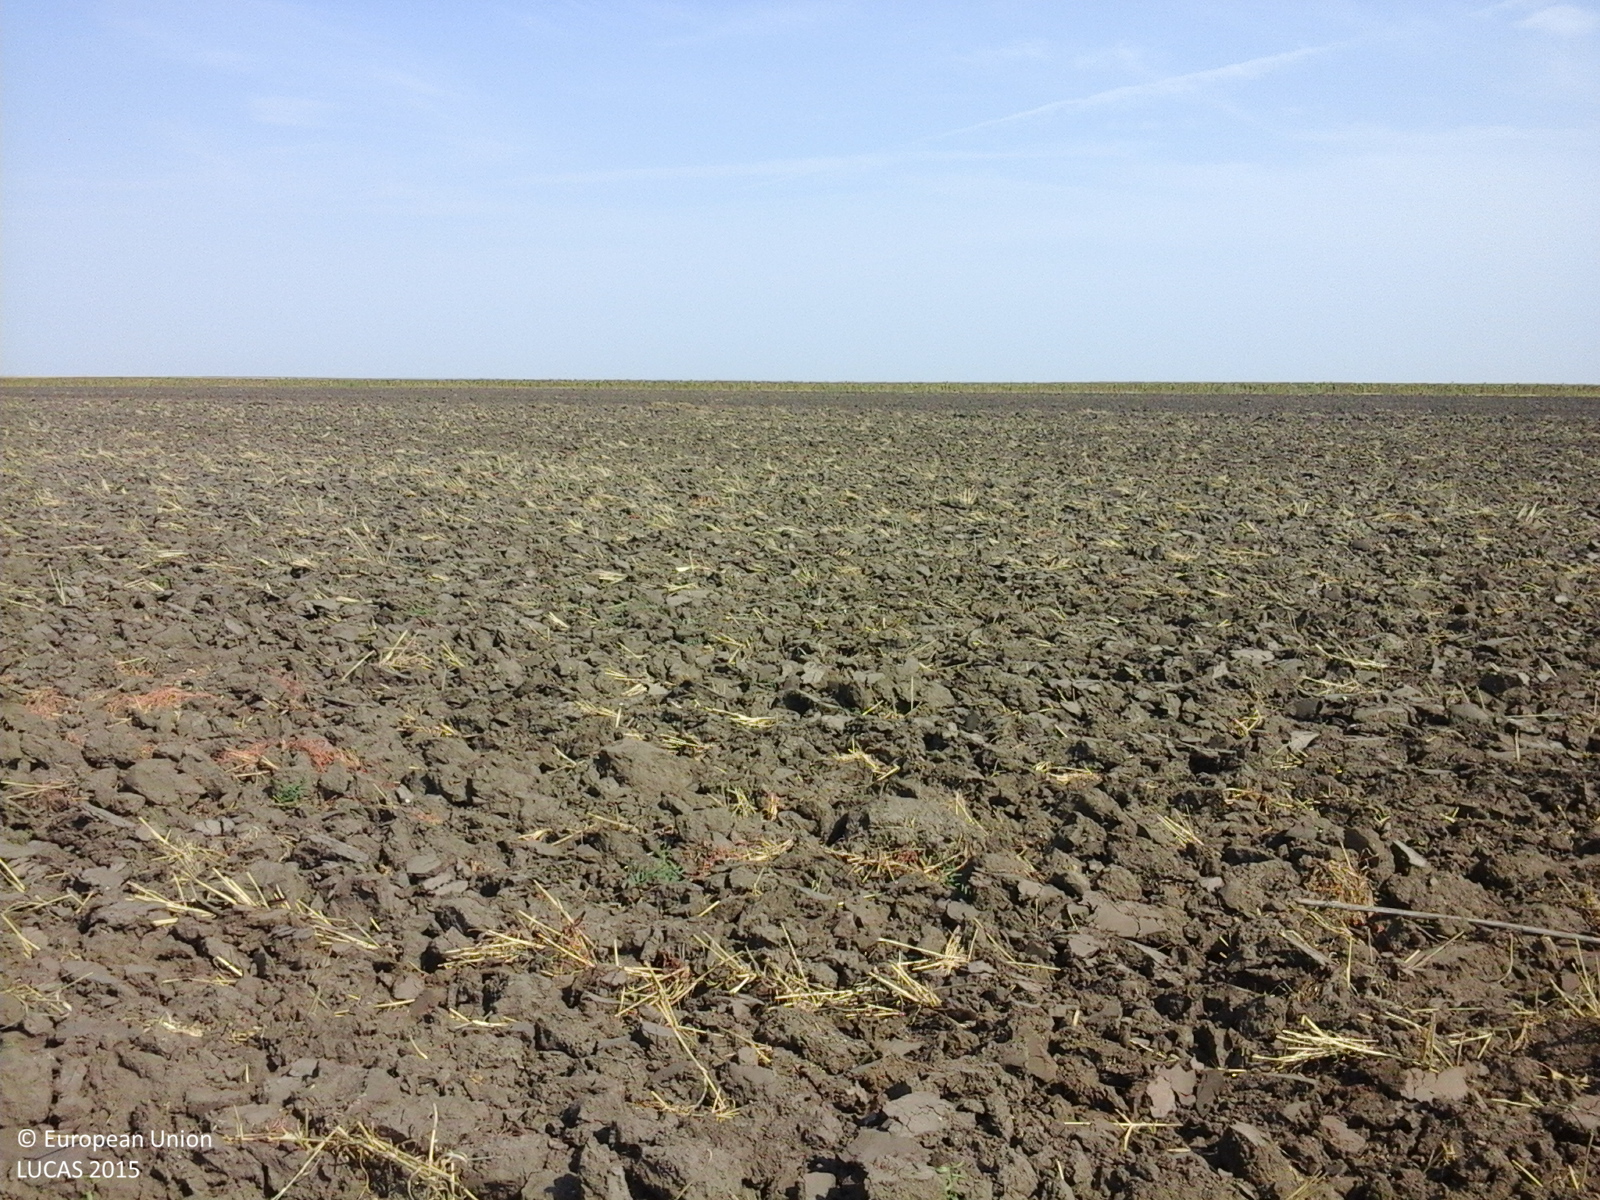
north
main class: Cropland
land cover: Common wheat
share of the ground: < 10 %
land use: Agriculture (excluding fallow land and kitchen gardens)
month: August
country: RO
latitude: 44.1169
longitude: 23.2539
